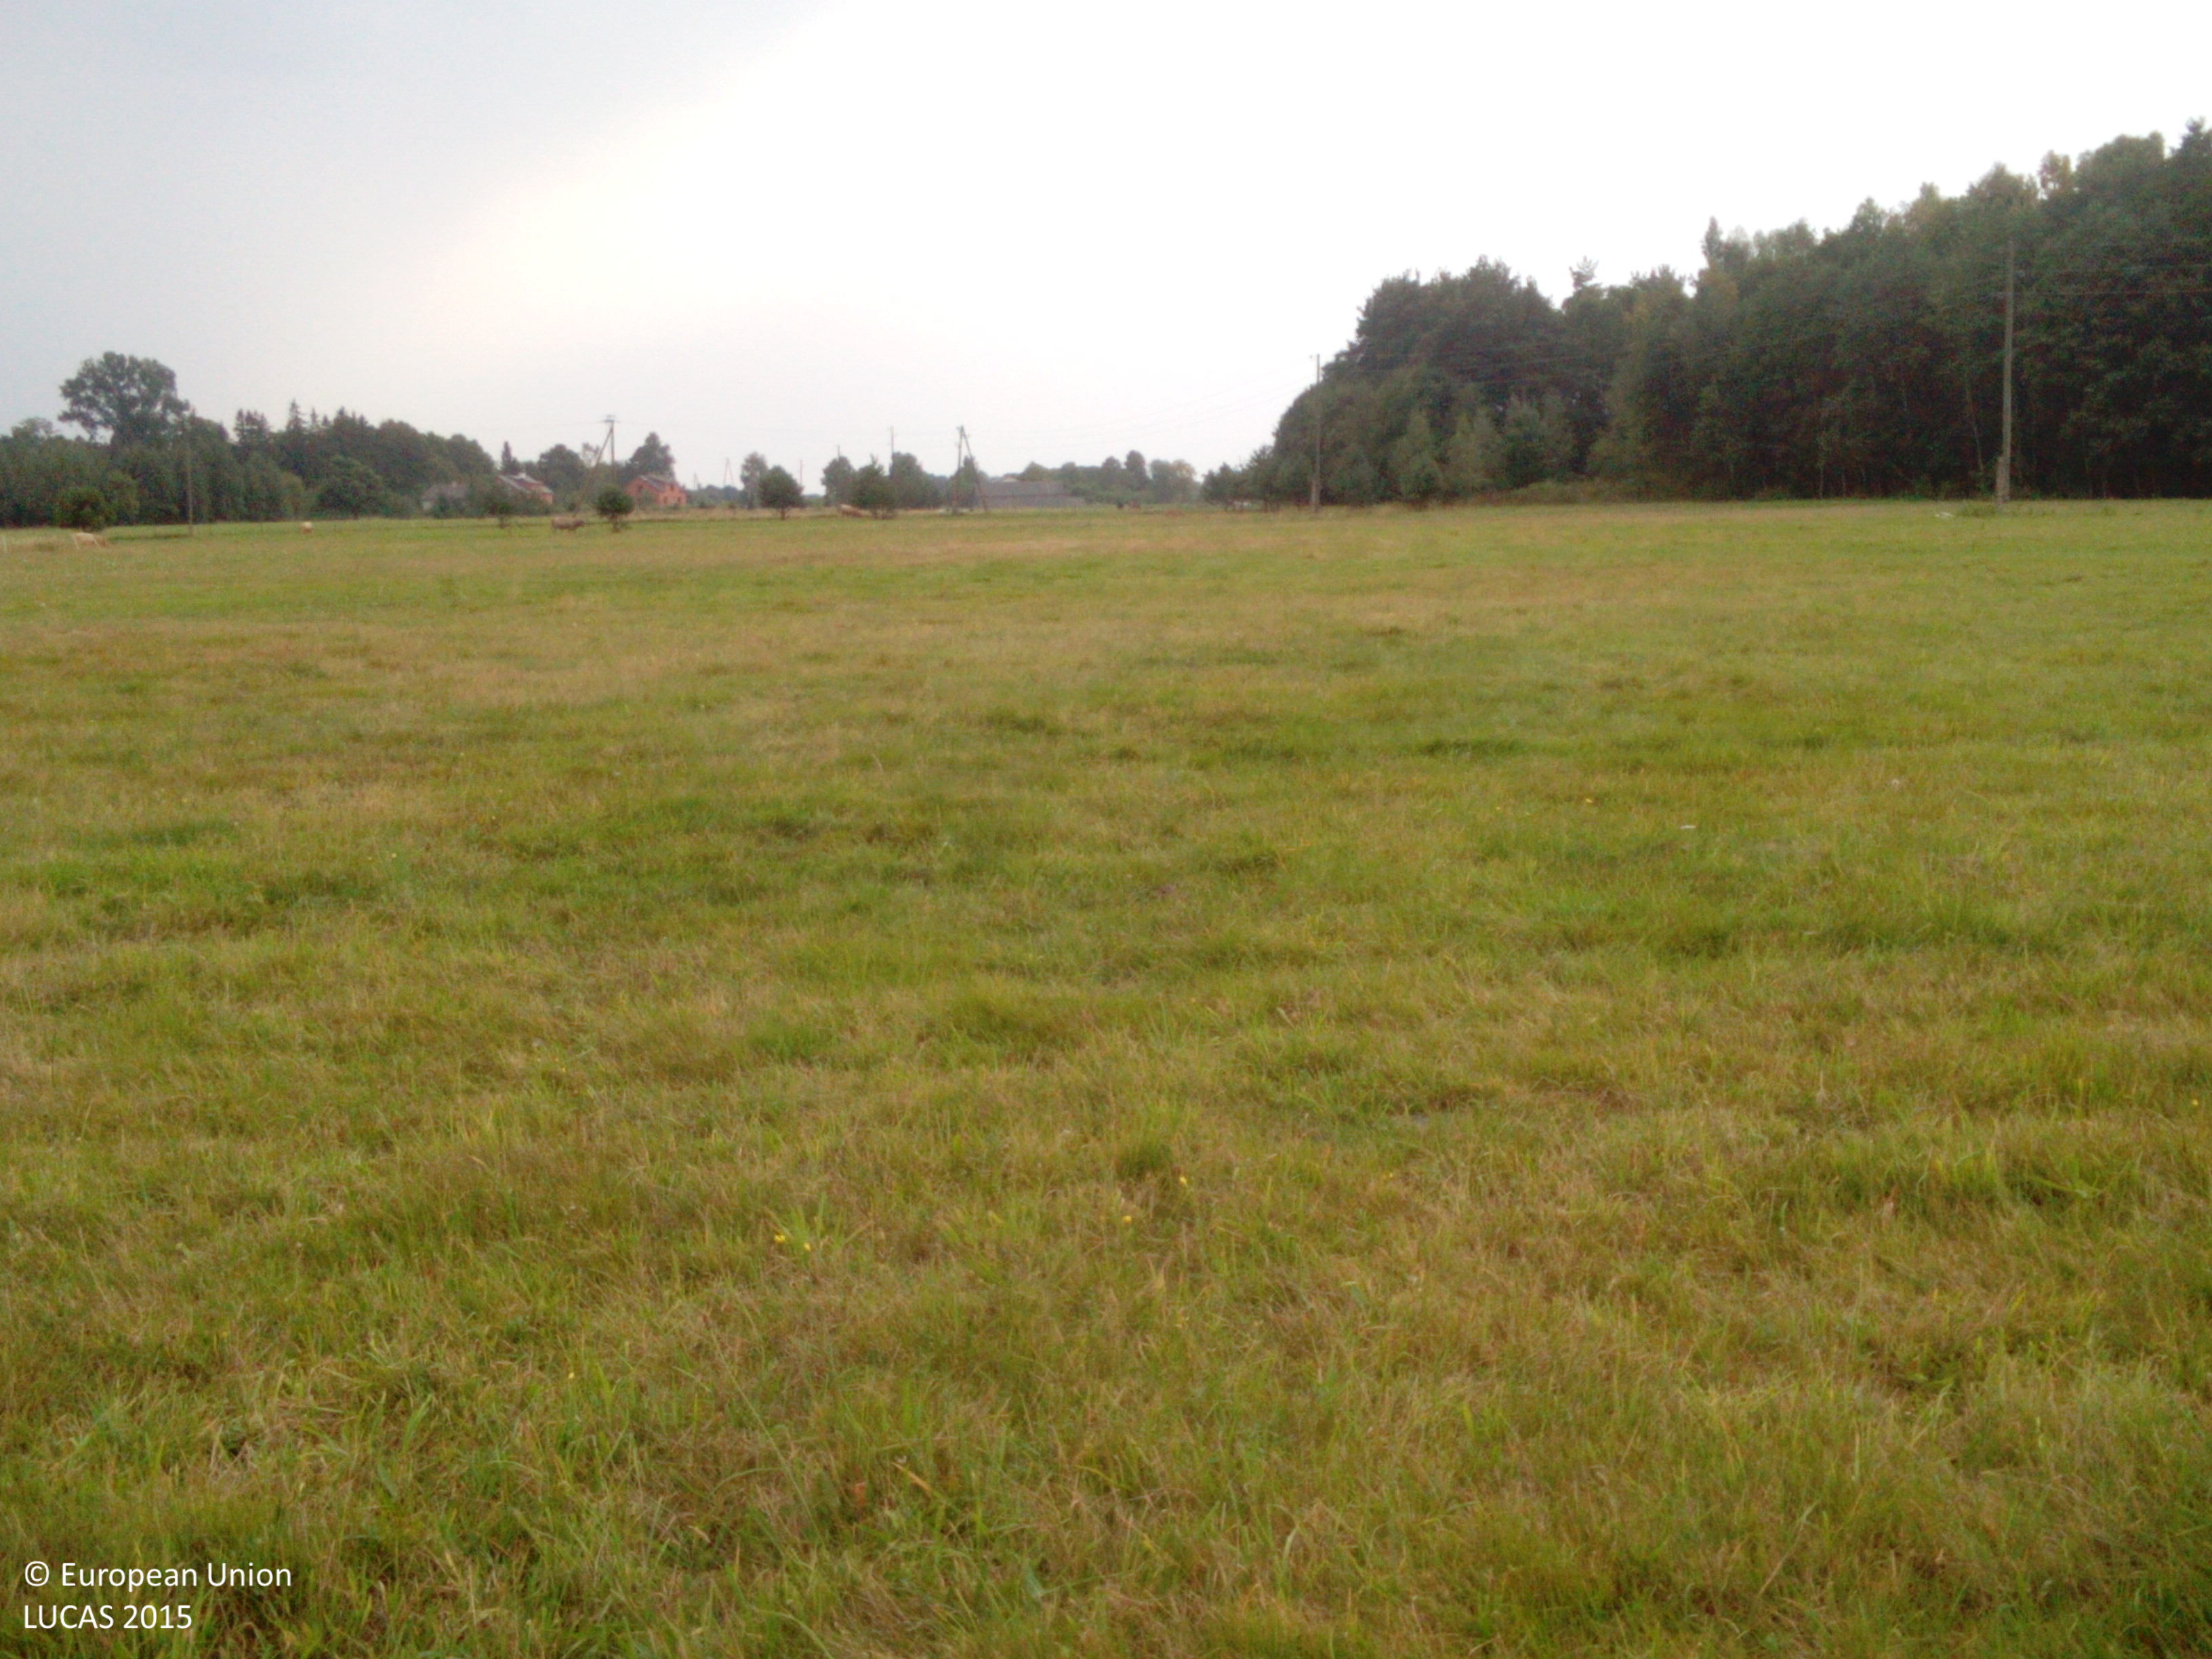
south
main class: Grassland
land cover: Grassland without tree/shrub cover
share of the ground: > 75 %
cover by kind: herbaceous plants 100 %
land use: Agriculture (excluding fallow land and kitchen gardens)
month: August
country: LV
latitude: 56.1710
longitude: 21.1683
